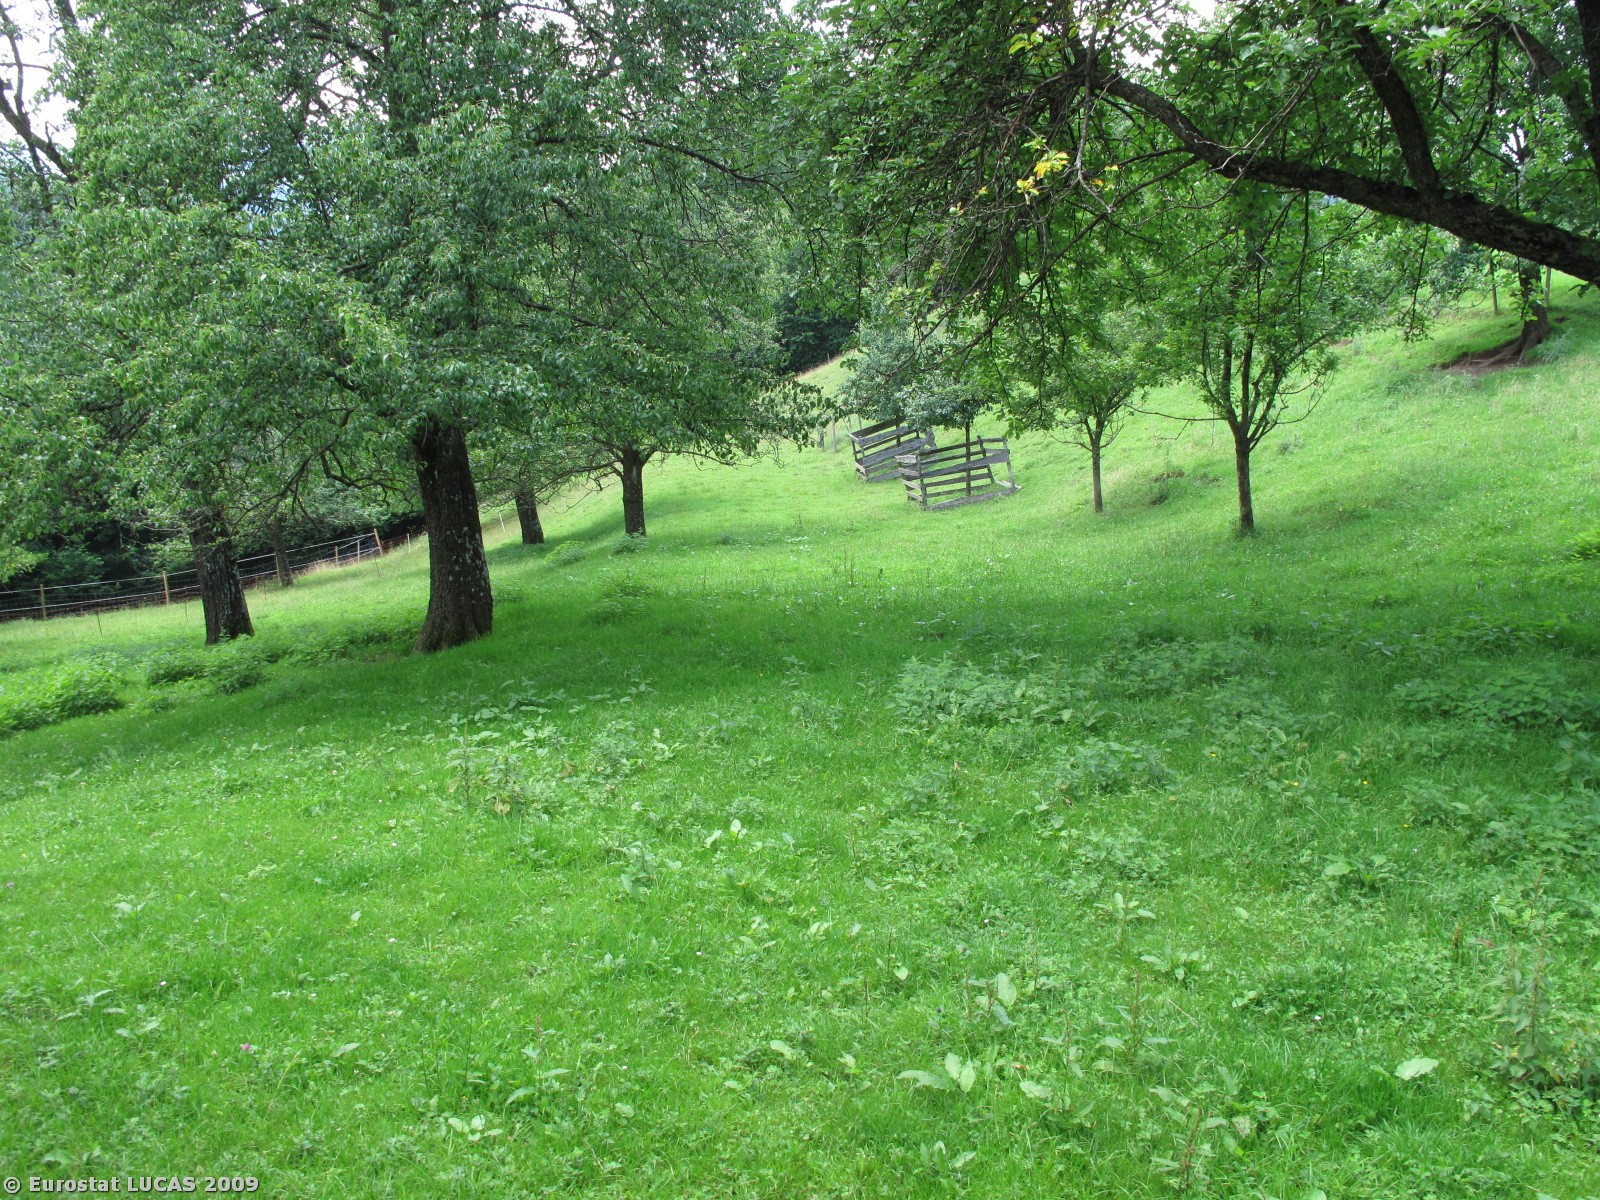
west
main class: Cropland
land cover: Pear fruit
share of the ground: 25 - 50 %
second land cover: Grassland with sparse tree/shrub cover
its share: > 75 %
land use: Agriculture (excluding fallow land and kitchen gardens)
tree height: > 5 m
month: July
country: AT
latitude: 48.0067
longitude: 15.6456
